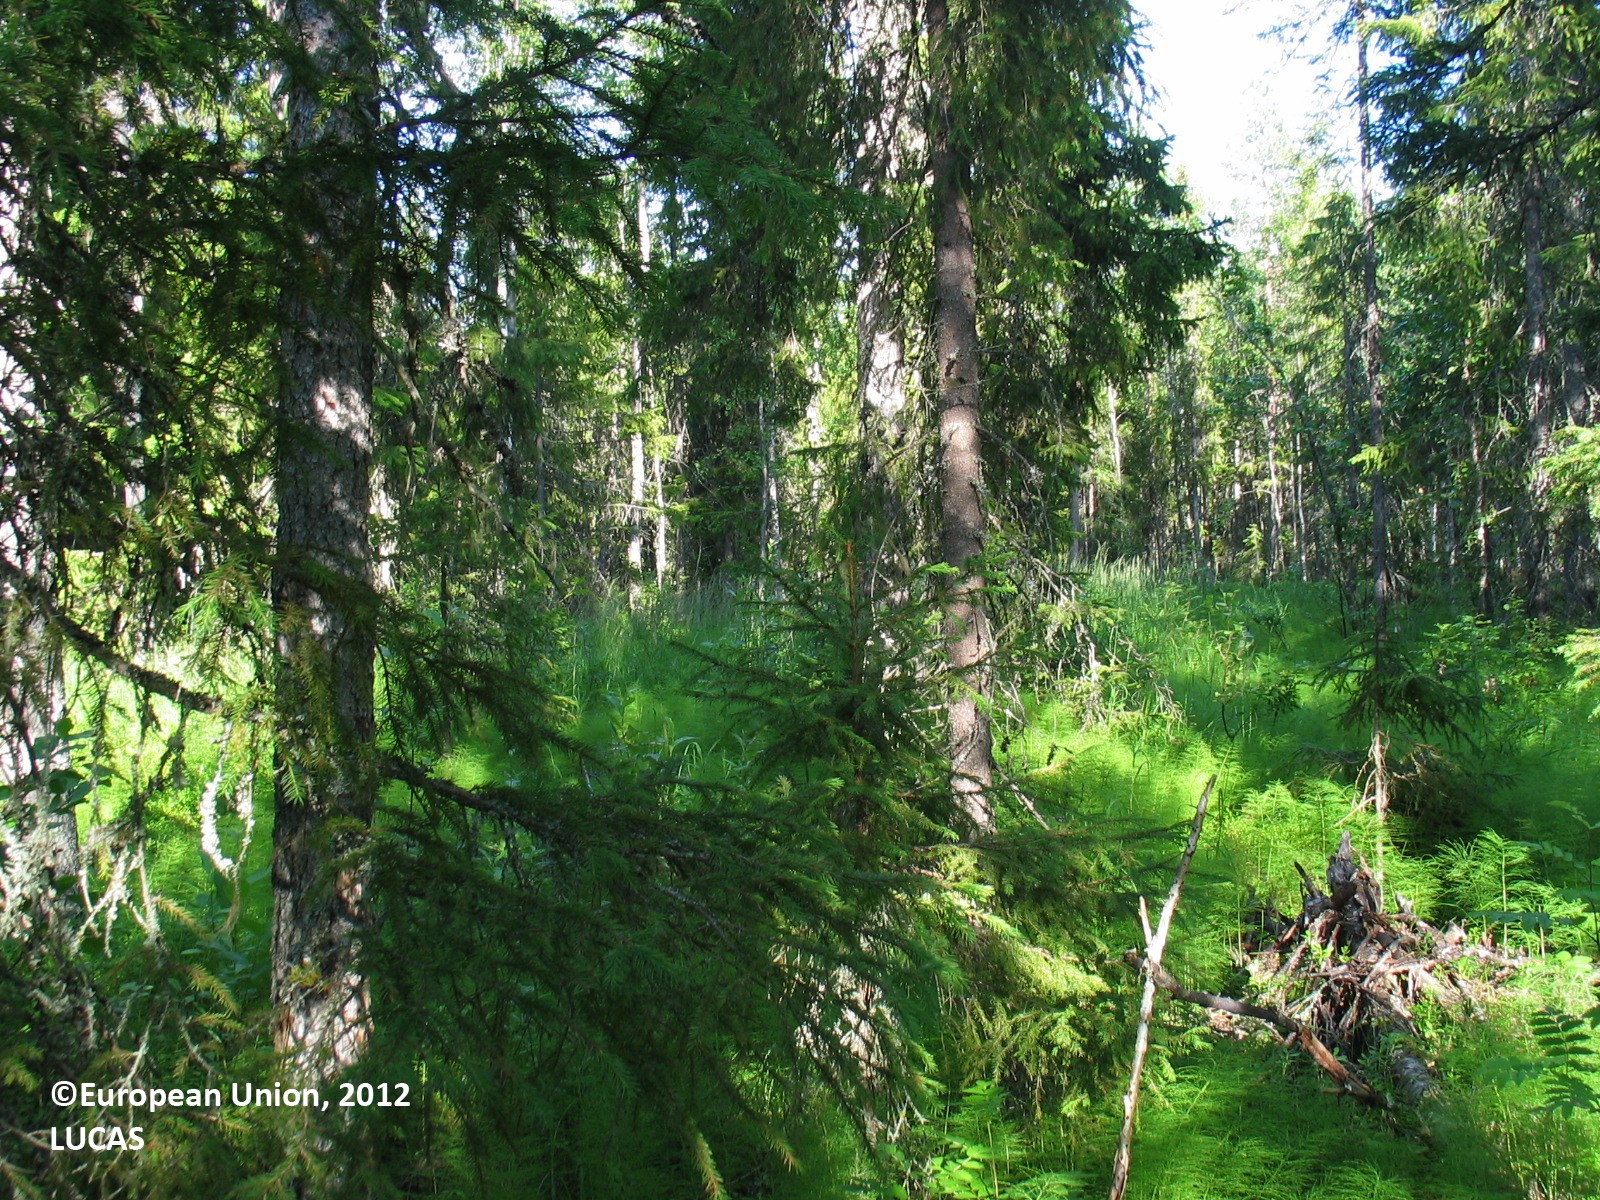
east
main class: Woodland
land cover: Other mixed woodland
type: boreal forest
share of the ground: 50 - 75 %
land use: Forestry
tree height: > 5 m
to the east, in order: Other mixed woodland; Grassland with sparse tree/shrub cover; Spruce dominated coniferous woodland; Other mixed woodland; Ditches and canals; Broadleaved woodland; Ditches and canals; Other mixed woodland; Pine dominated coniferous woodland; Ditches and canals; Pine dominated coniferous woodland
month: July
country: FI
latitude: 65.9546
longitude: 25.1746
